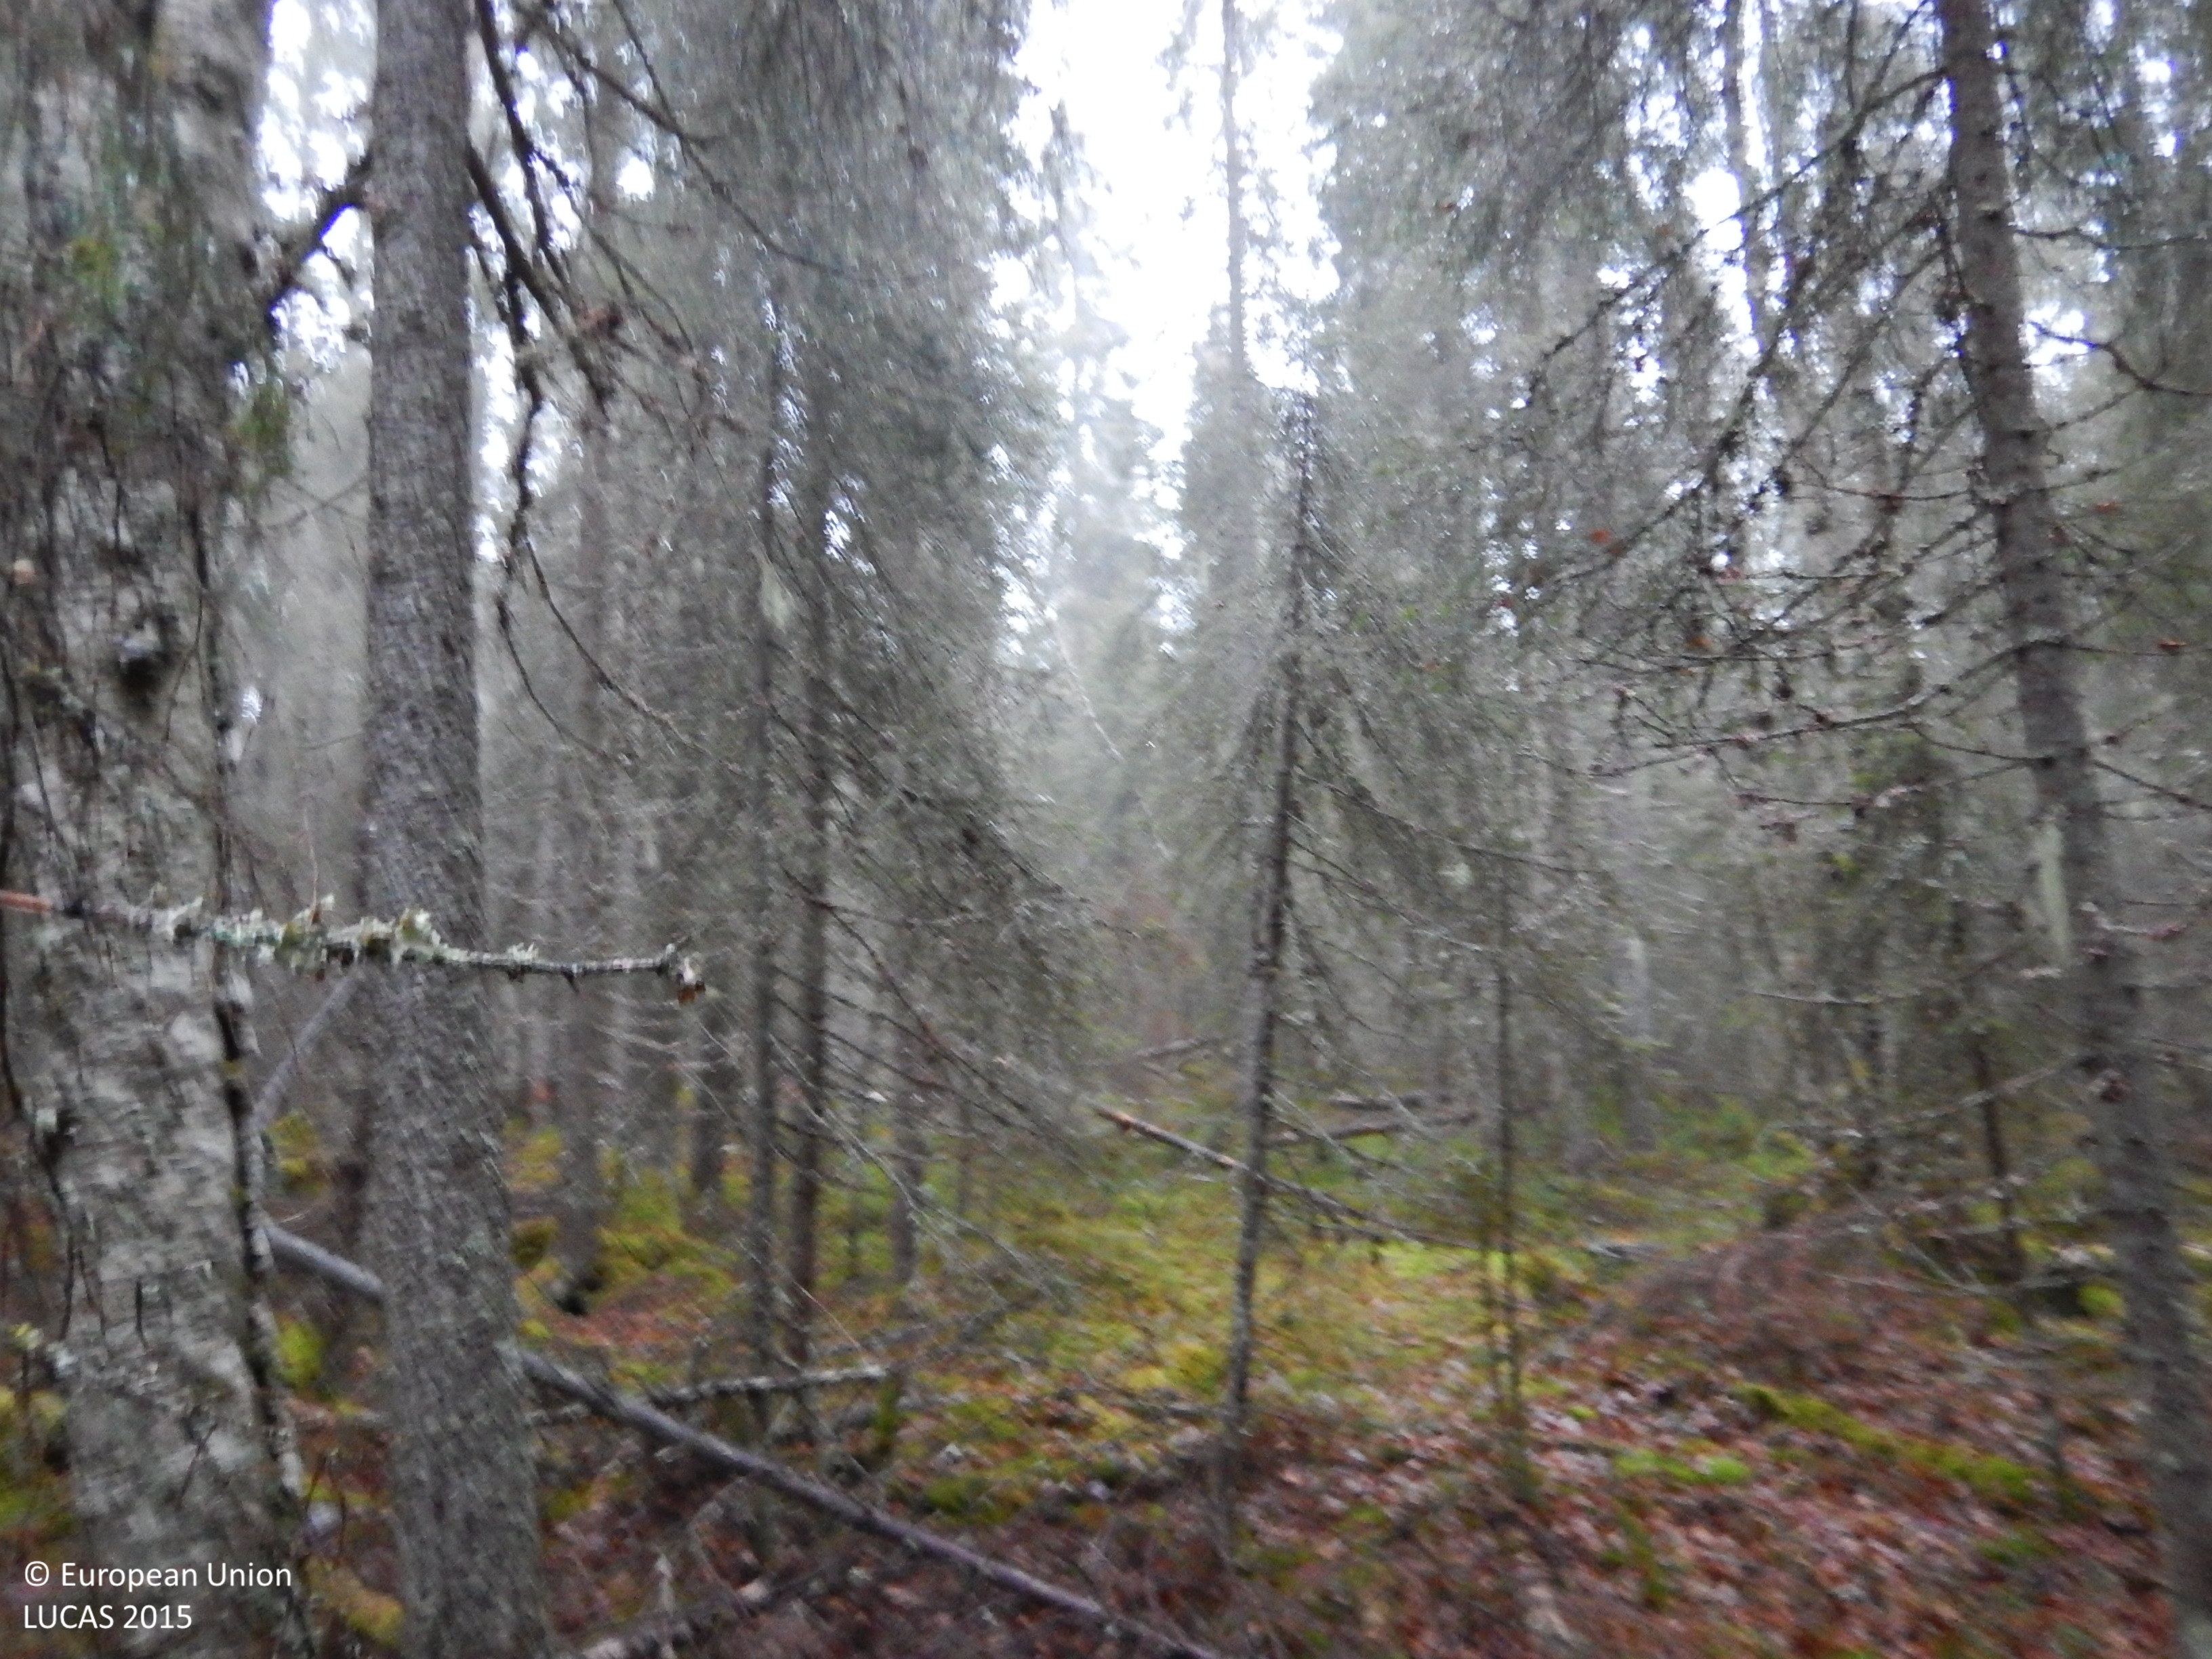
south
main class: Woodland
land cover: Spruce dominated mixed woodland
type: boreal forest
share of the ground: > 75 %
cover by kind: coniferous forest trees 60 %, broadleaved forest trees 20 %, shrubs 10 %, herbaceous plants 5 %, lichens and mosses 5 %
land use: Forestry
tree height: > 5 m
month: November
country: SE
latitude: 65.1402
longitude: 20.5665
